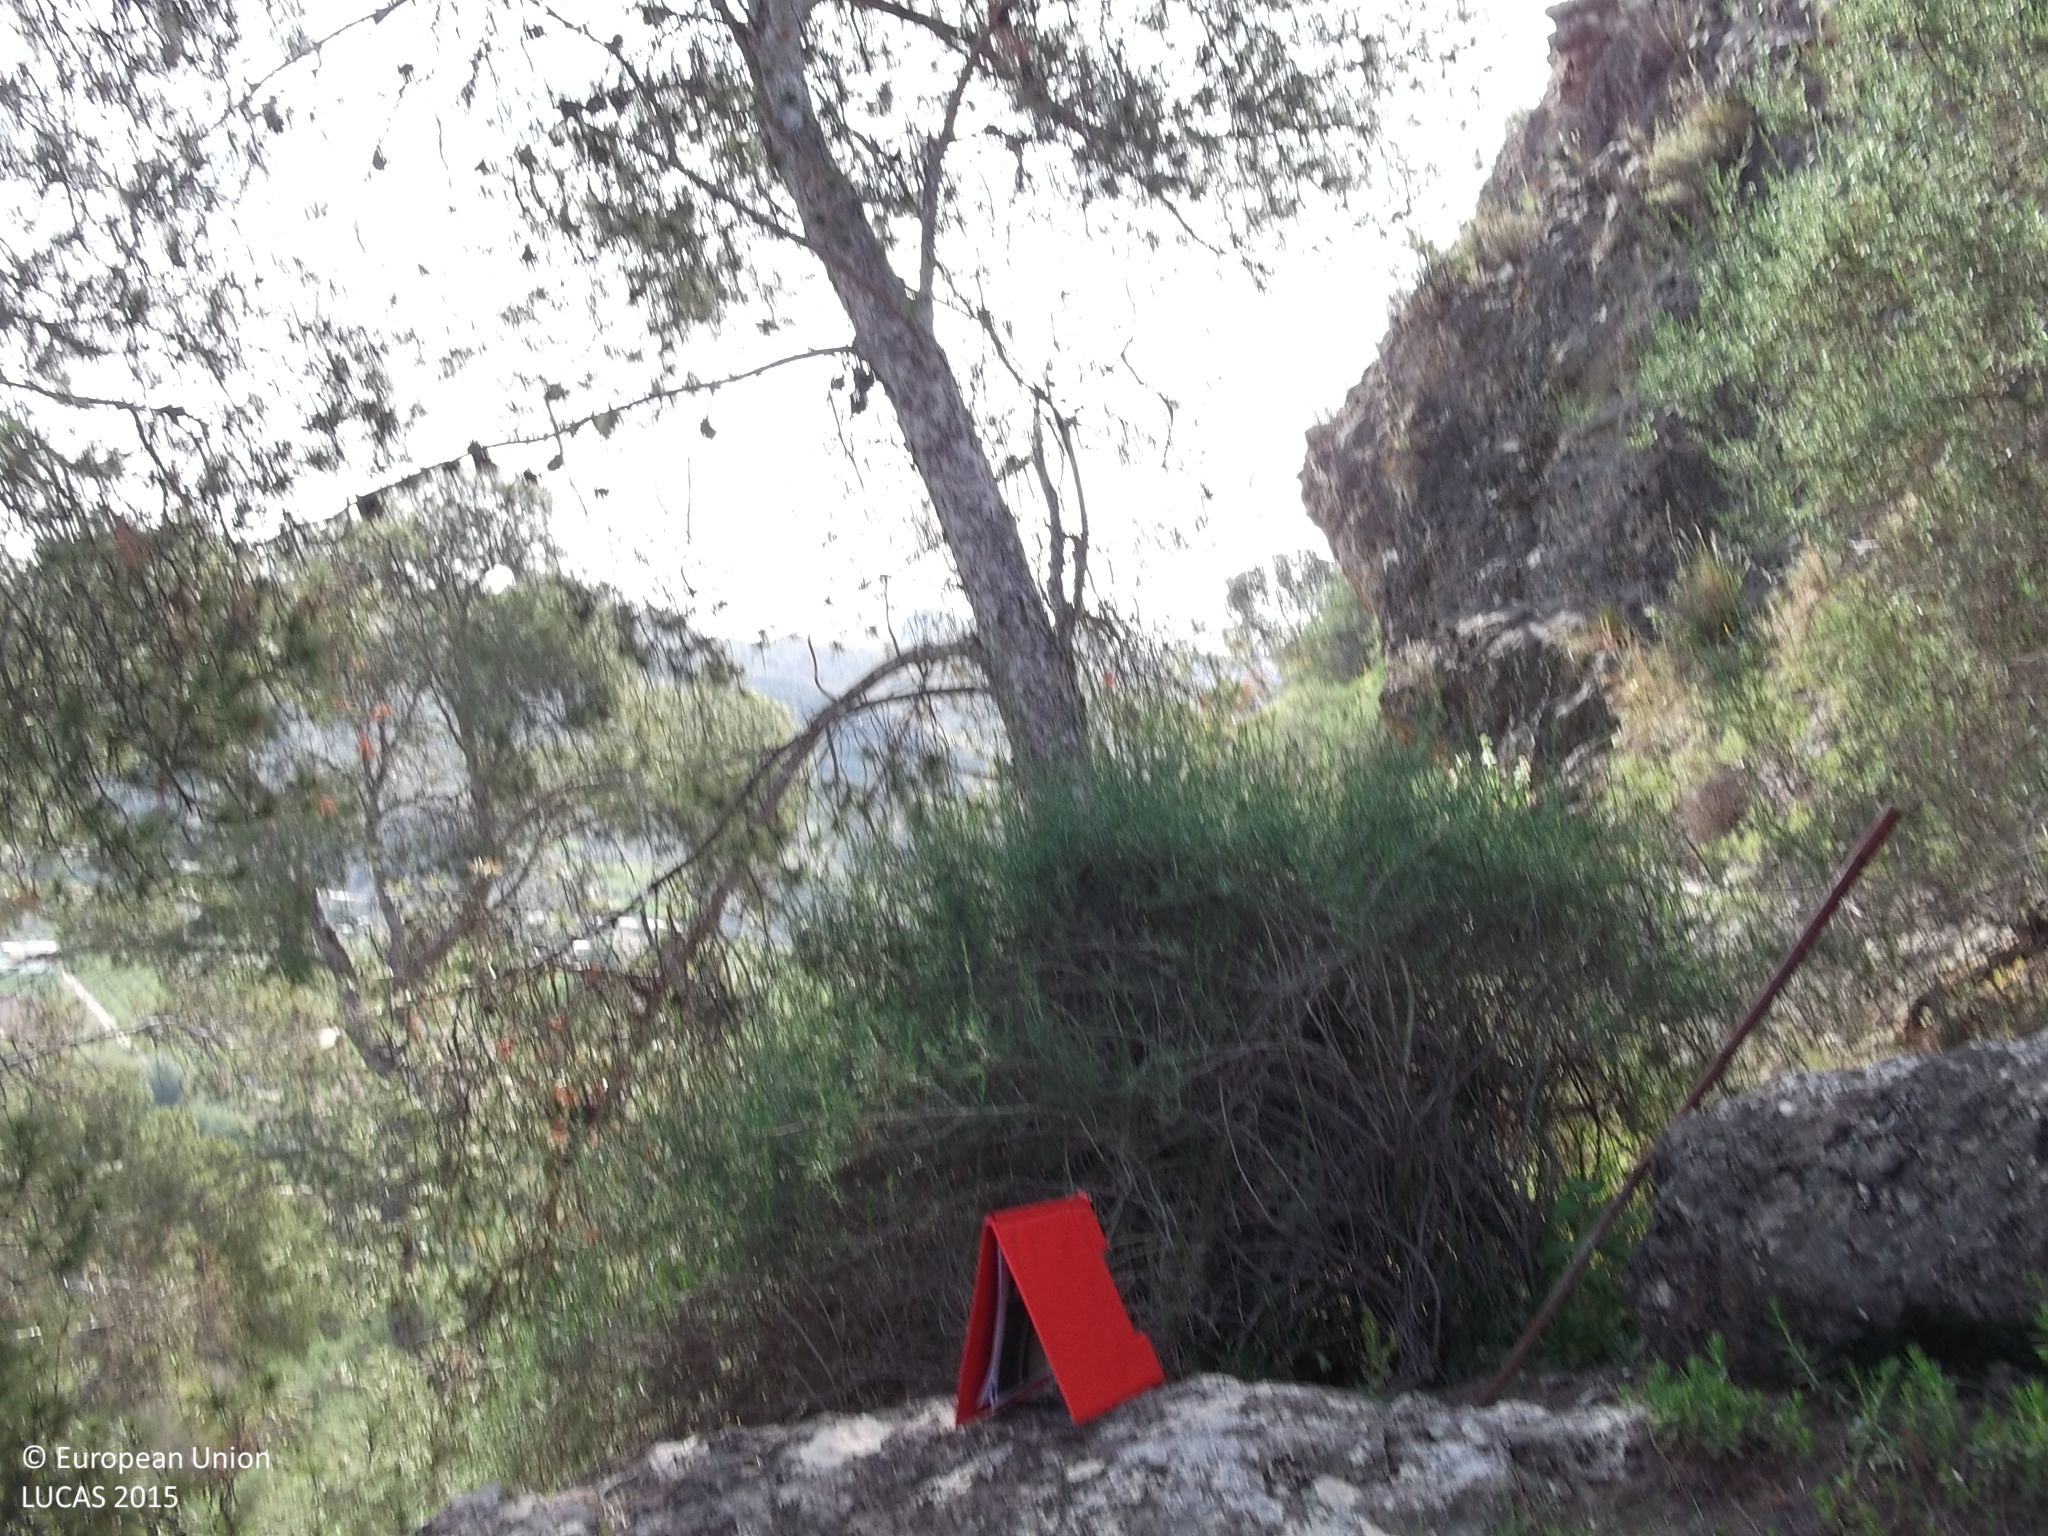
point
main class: Woodland
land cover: Pine dominated coniferous woodland
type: coniferous forest of the mediterranean region
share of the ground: 10 - 25 %
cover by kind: shrubs 65 %, herbaceous plants 20 %, coniferous forest trees 15 %
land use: Semi-natural and natural areas not in use
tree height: > 5 m
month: April
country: ES
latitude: 38.2276
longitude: -1.4231
